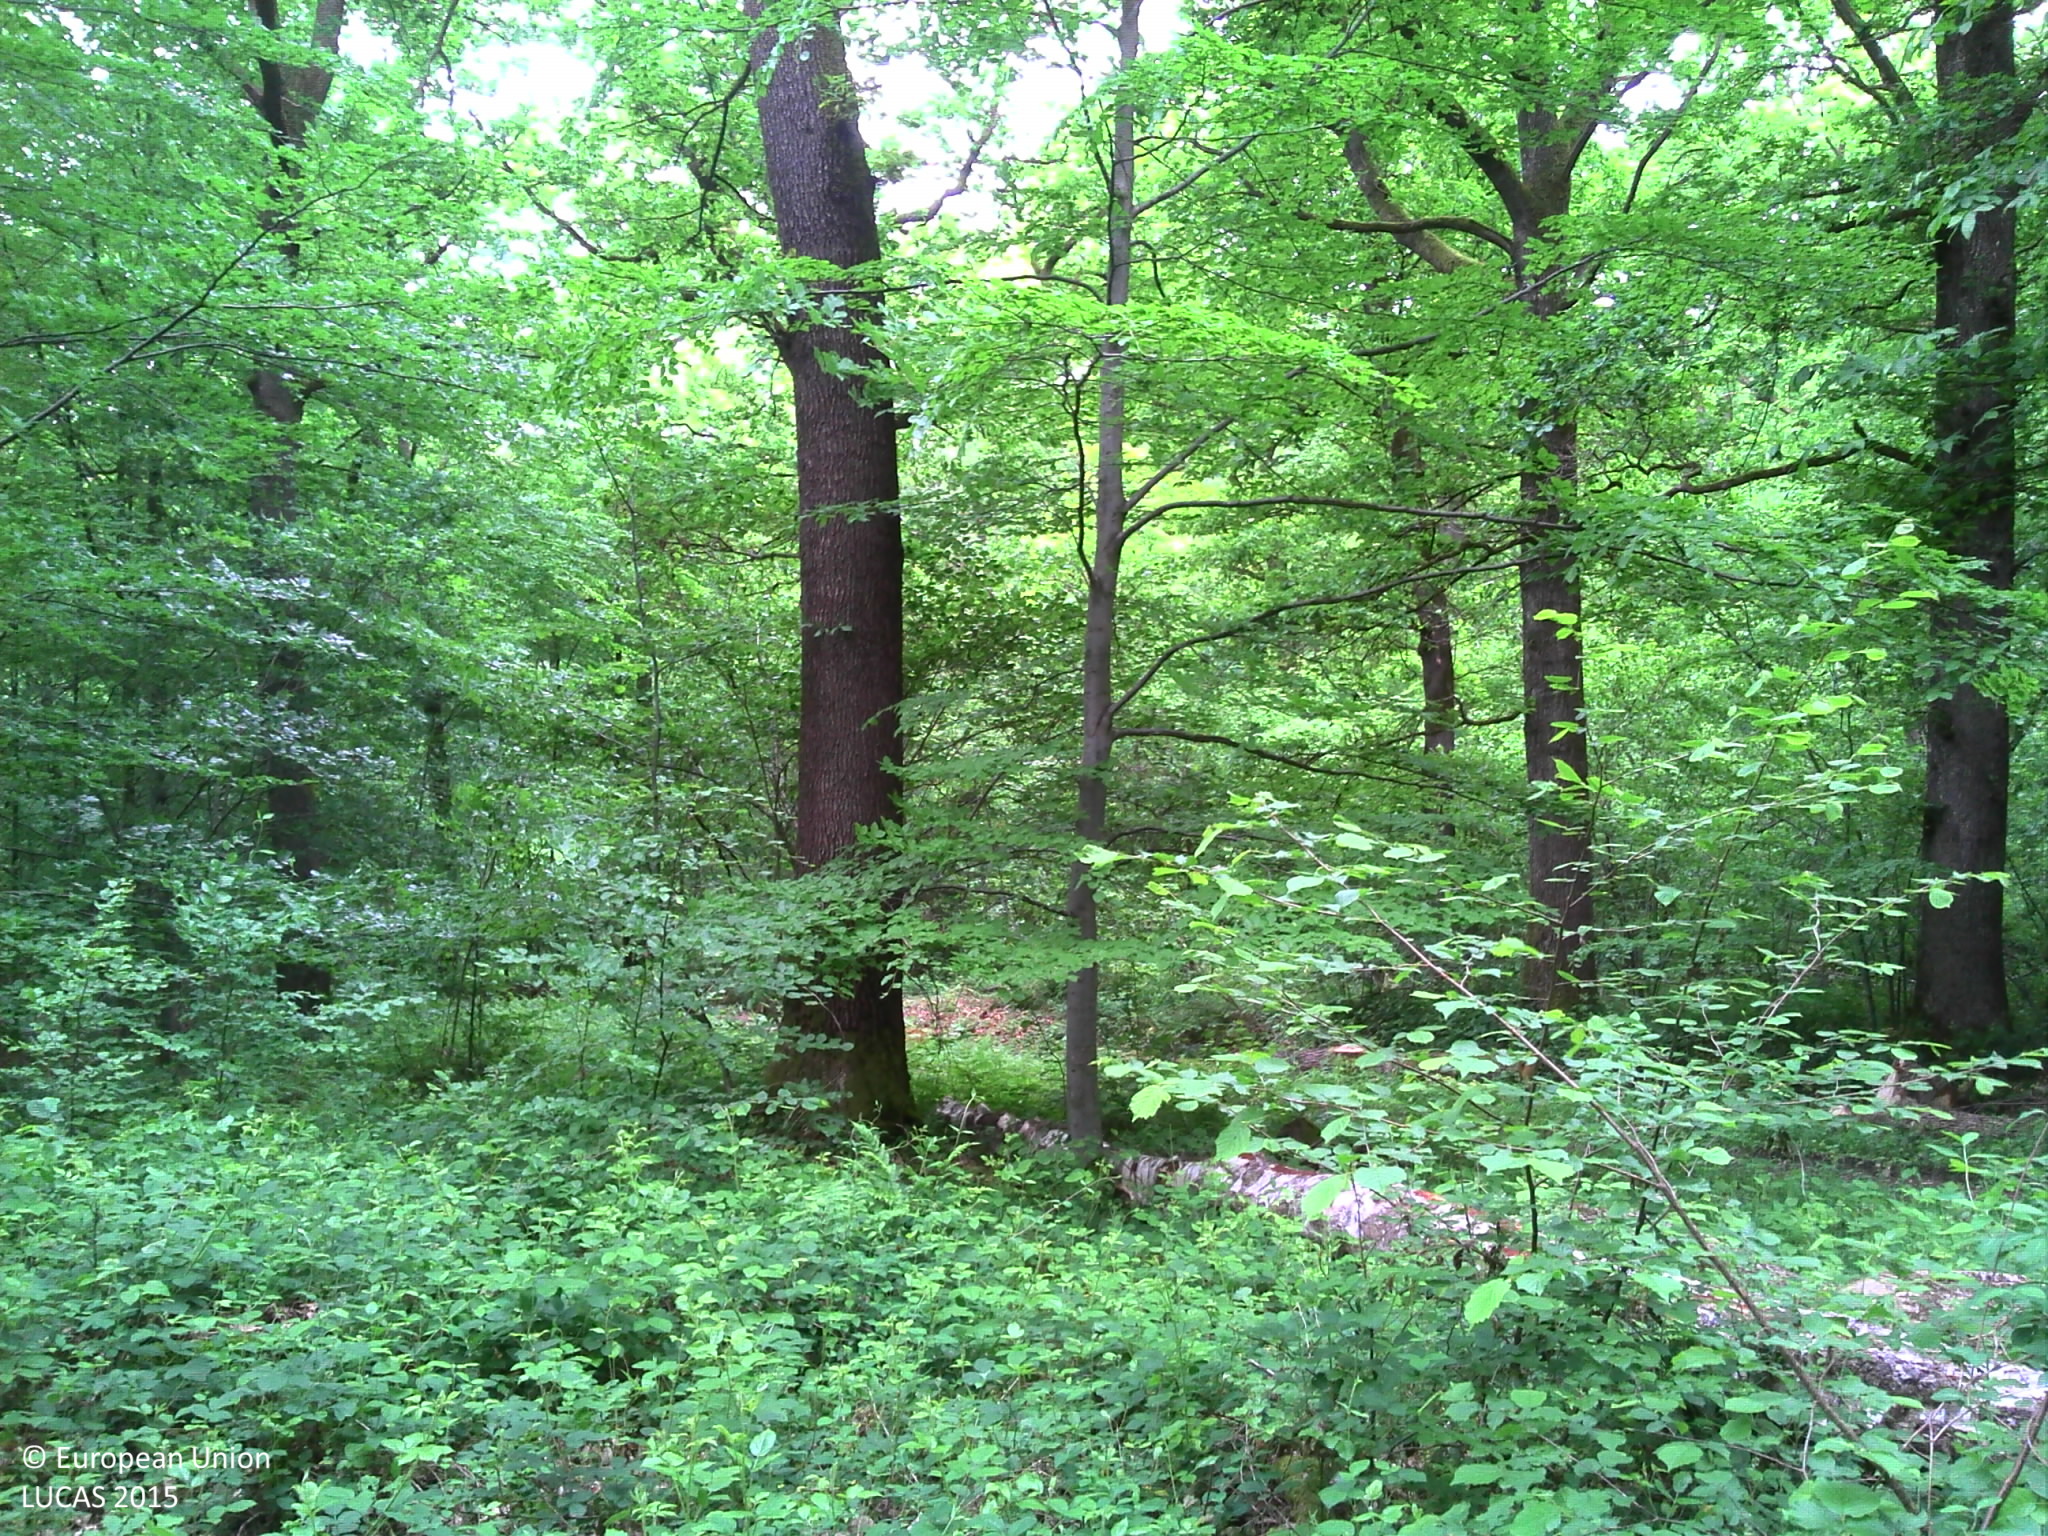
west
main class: Woodland
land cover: Broadleaved woodland
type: acidophilous oak and oak-birch forest
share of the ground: > 75 %
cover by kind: broadleaved forest trees 85 %, herbaceous plants 15 %
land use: Forestry
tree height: > 5 m
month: June
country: BE
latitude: 50.4053
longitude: 5.5944
